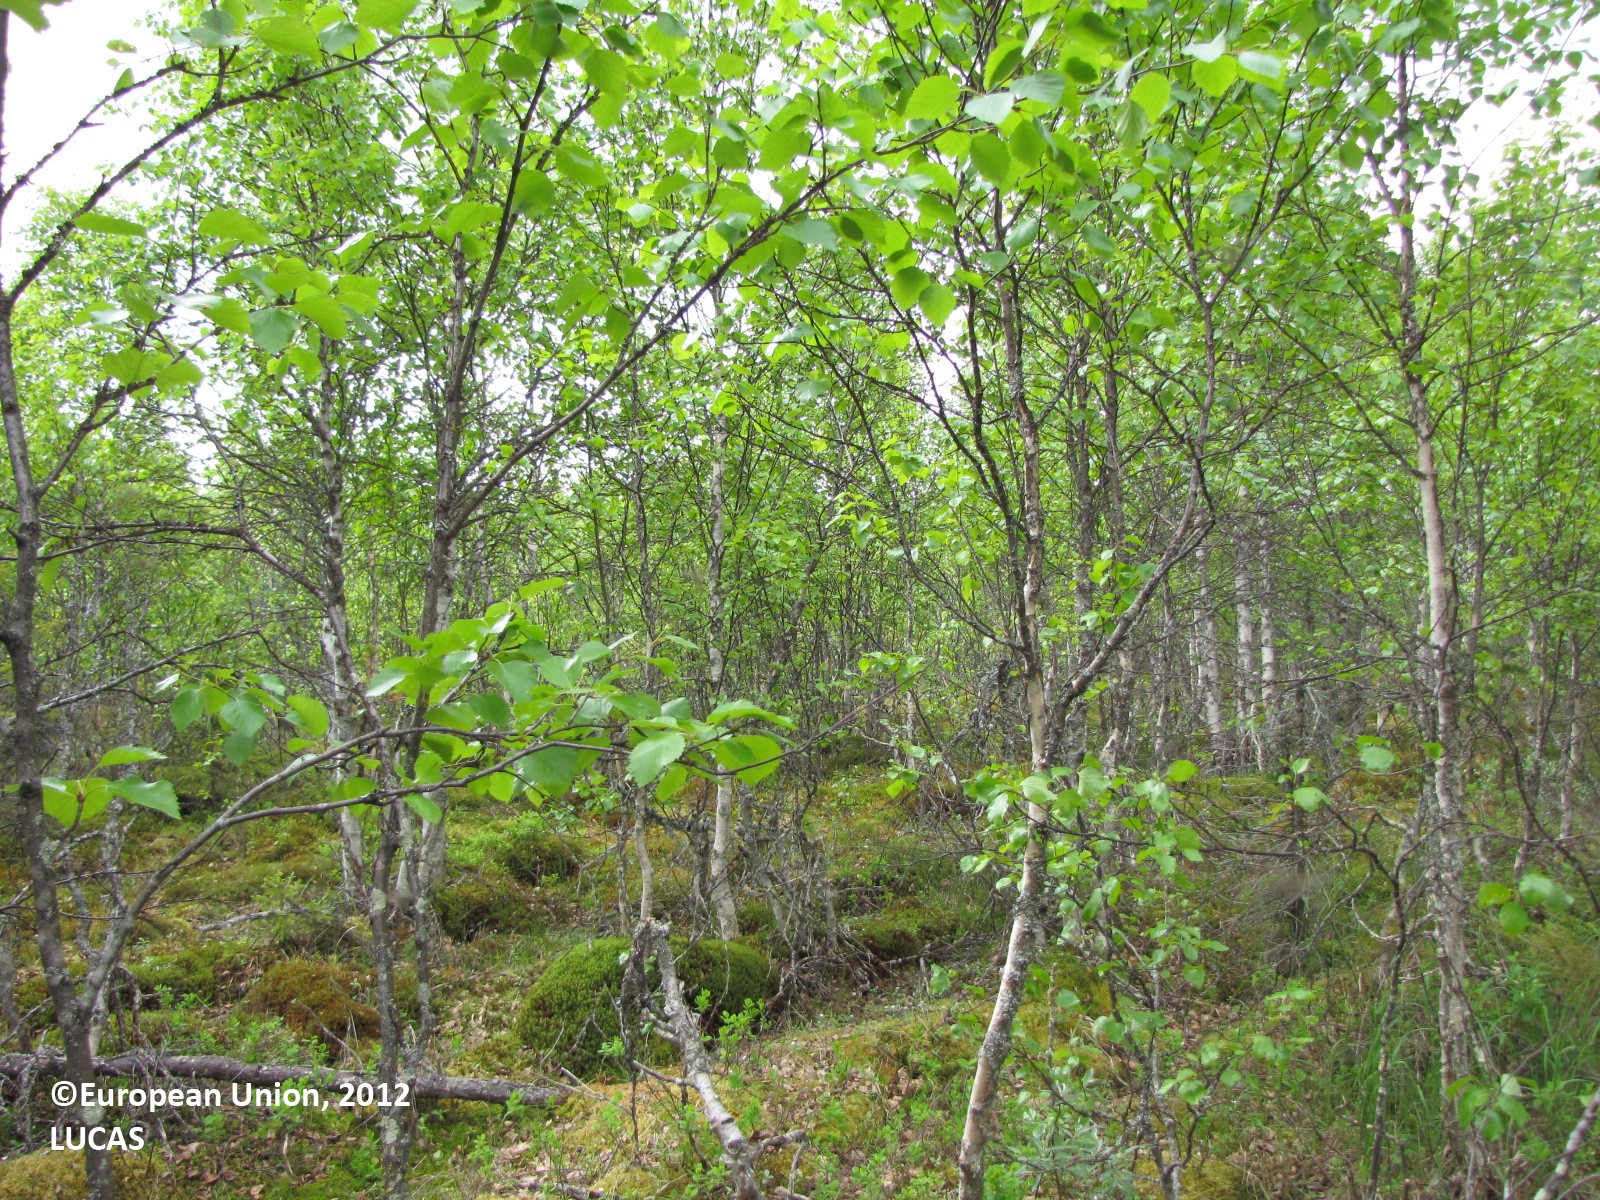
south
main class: Woodland
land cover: Broadleaved woodland
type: boreal forest
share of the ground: > 75 %
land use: Forestry
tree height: > 5 m
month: June
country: FI
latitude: 66.1492
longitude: 24.6573
